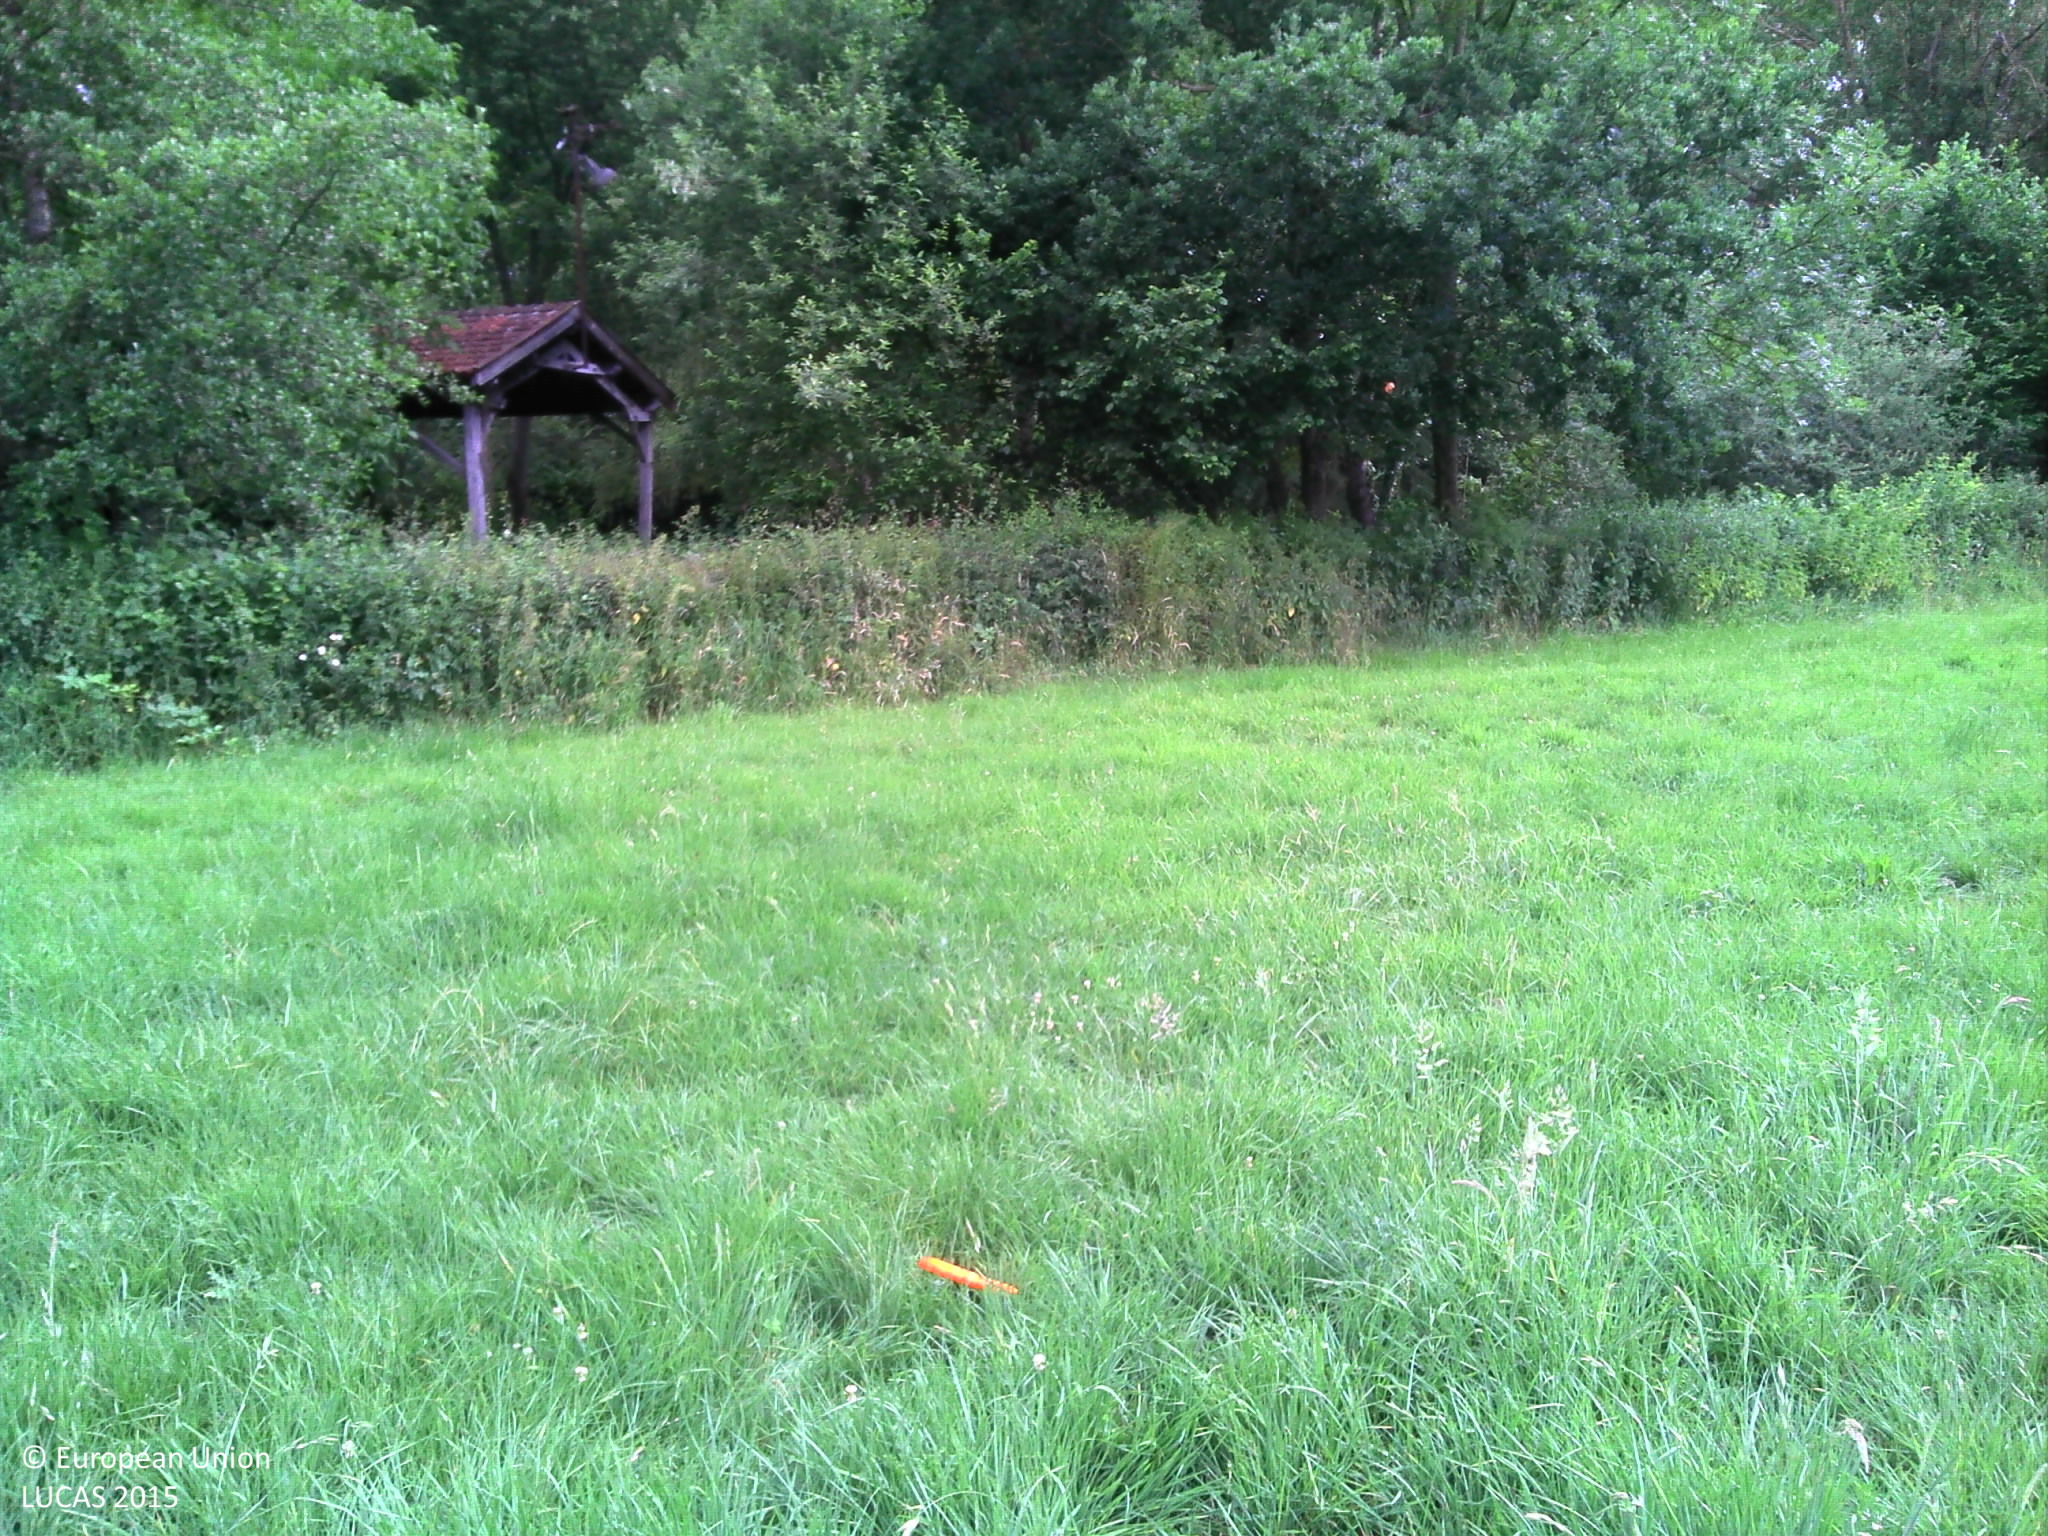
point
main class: Grassland
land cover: Grassland without tree/shrub cover
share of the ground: > 75 %
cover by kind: herbaceous plants 100 %
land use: Agriculture (excluding fallow land and kitchen gardens)
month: June
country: FR
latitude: 46.3211
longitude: 4.5600
